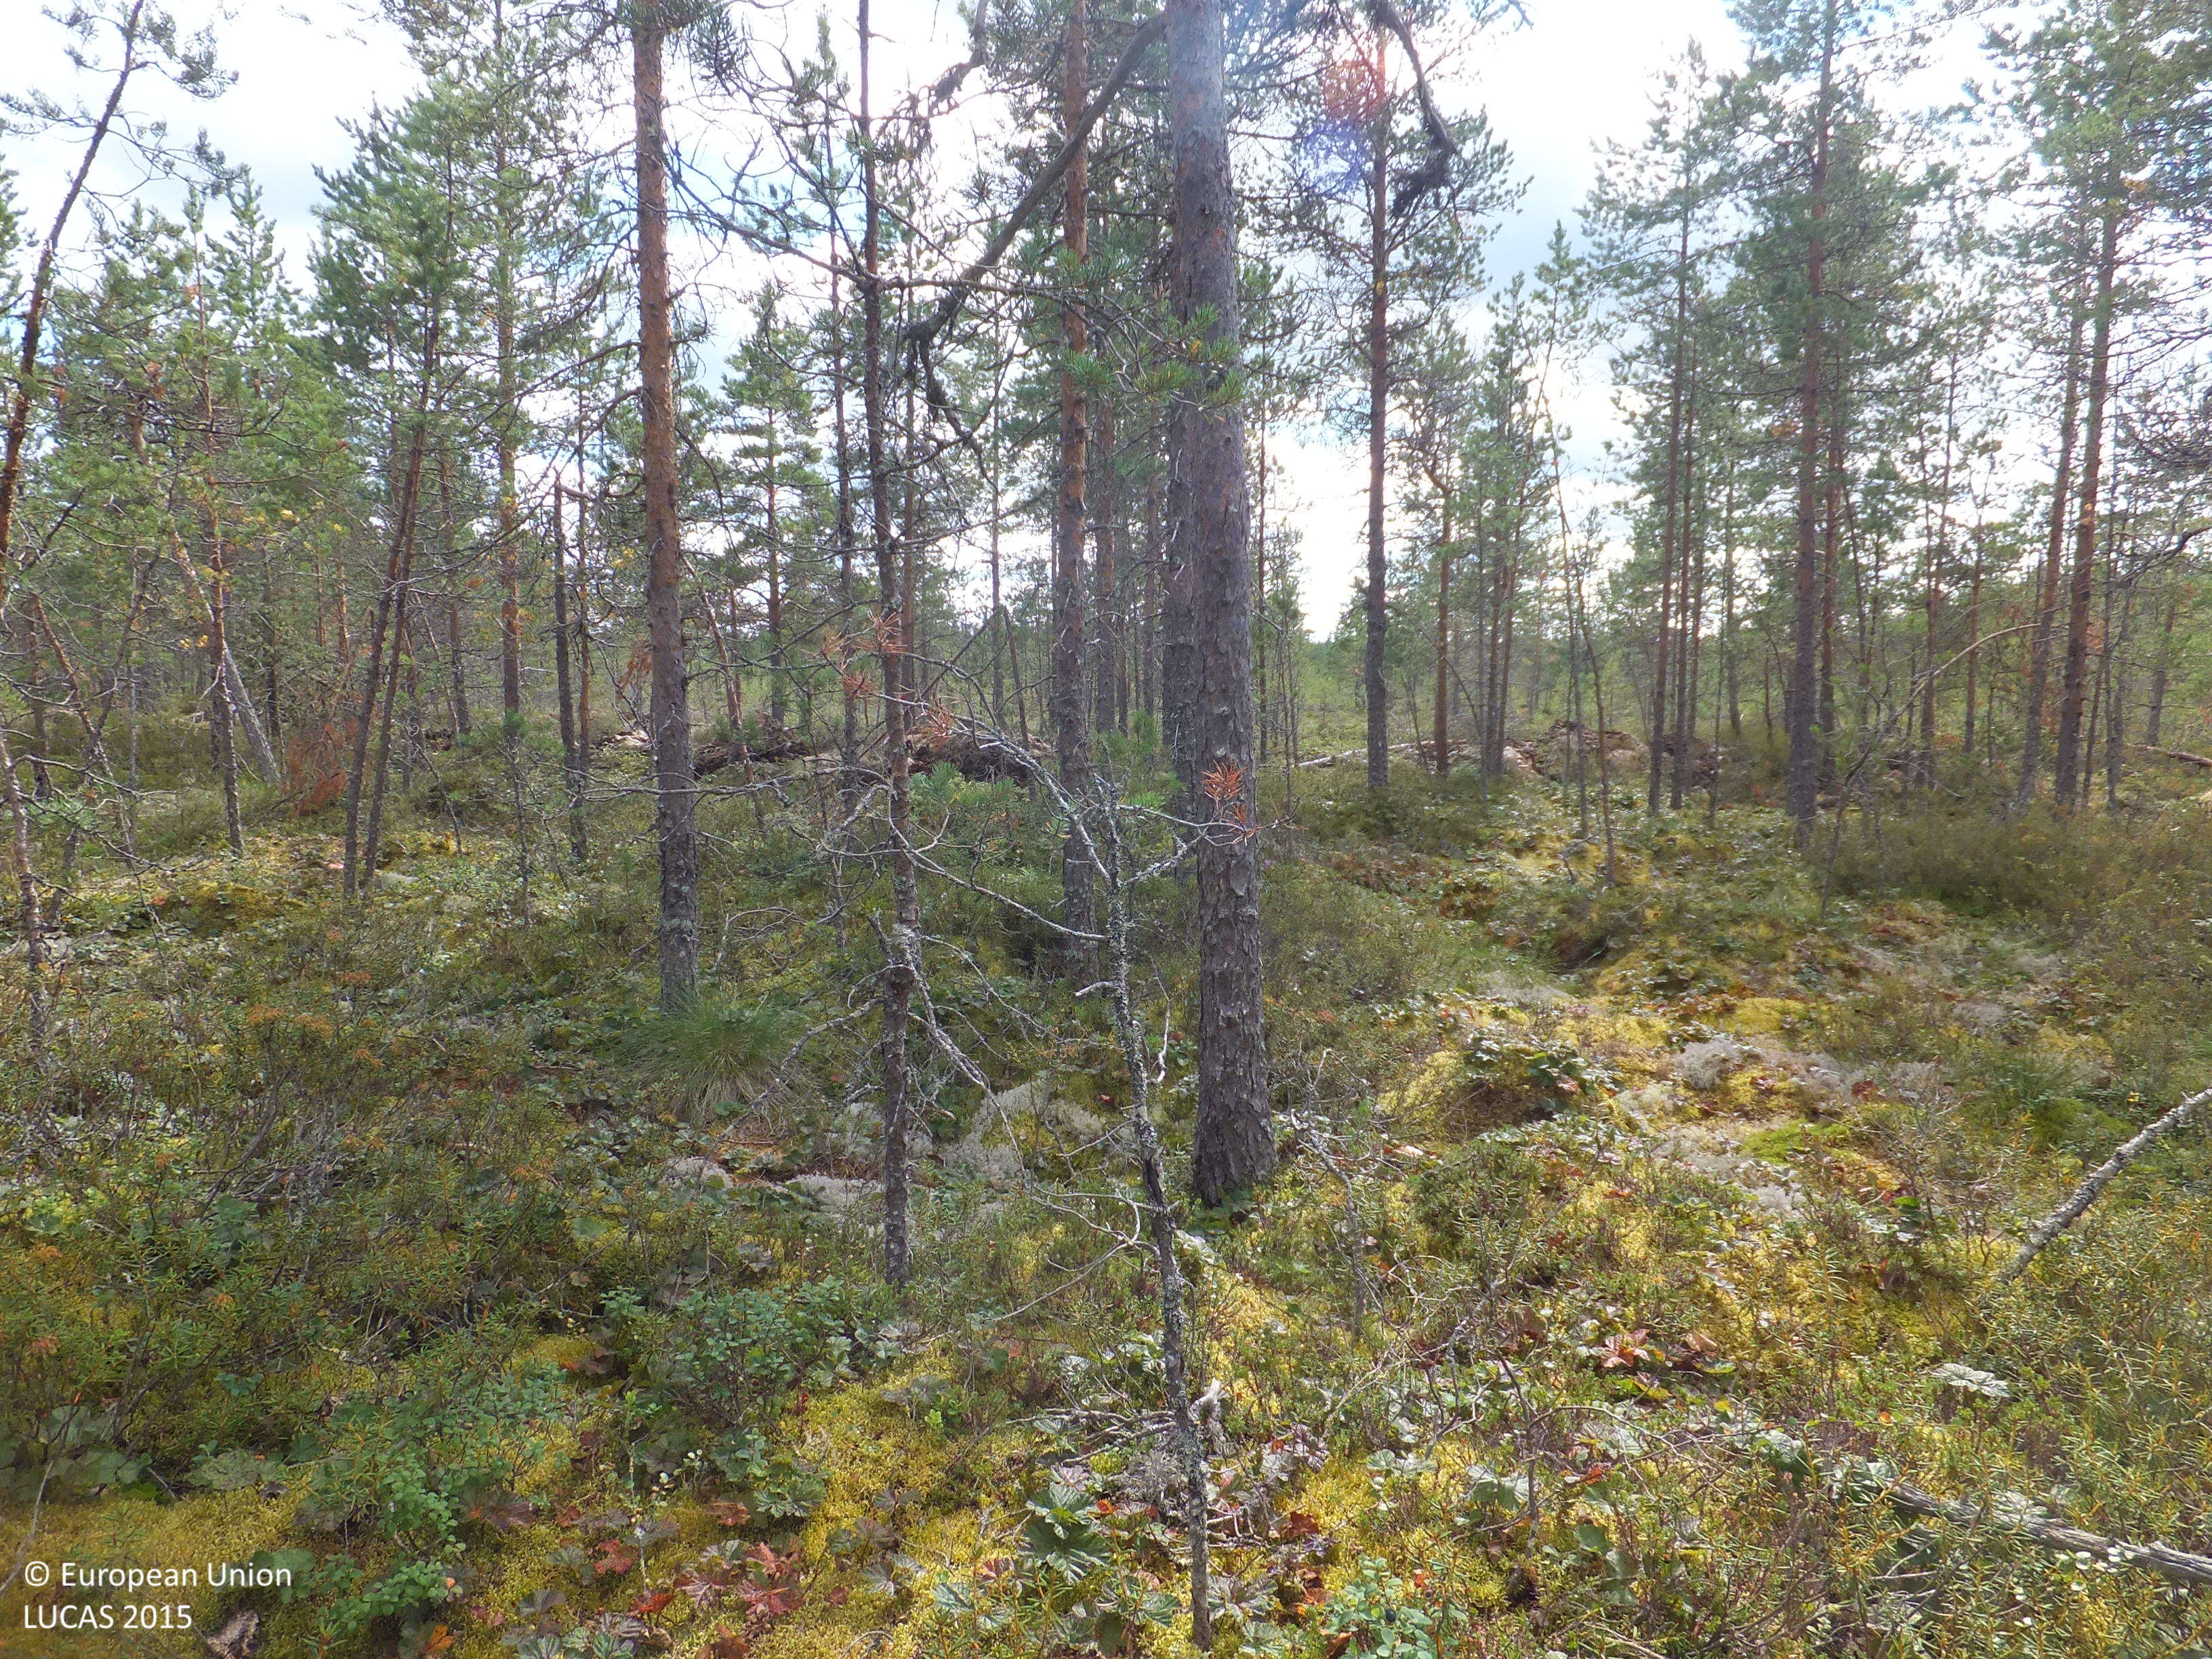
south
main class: Woodland
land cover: Pine dominated coniferous woodland
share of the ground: 25 - 50 %
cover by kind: coniferous forest trees 45 %, shrubs 25 %, lichens and mosses 20 %, herbaceous plants 10 %
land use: Forestry
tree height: < 5 m
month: August
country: FI
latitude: 63.2726
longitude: 23.4359
